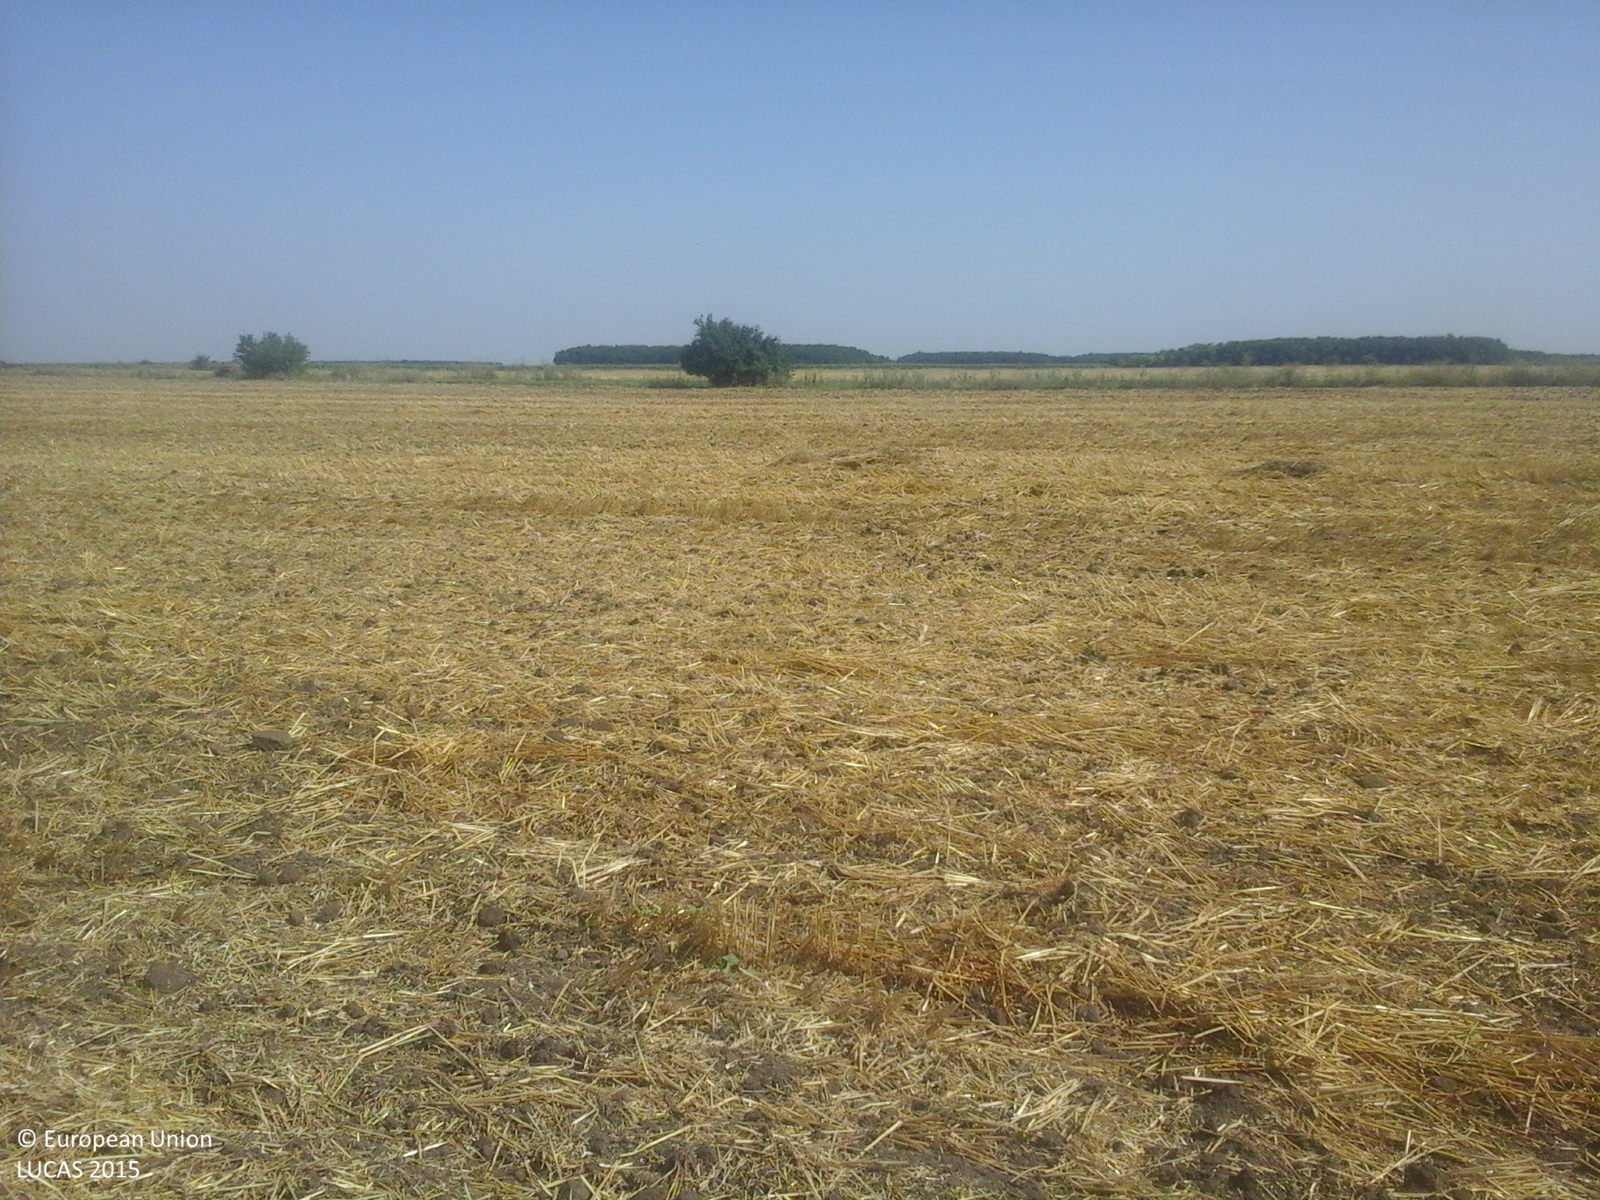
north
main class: Cropland
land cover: Common wheat
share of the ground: 10 - 25 %
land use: Agriculture (excluding fallow land and kitchen gardens)
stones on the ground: < 10 %
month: July
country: RO
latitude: 44.3665
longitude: 27.1341
